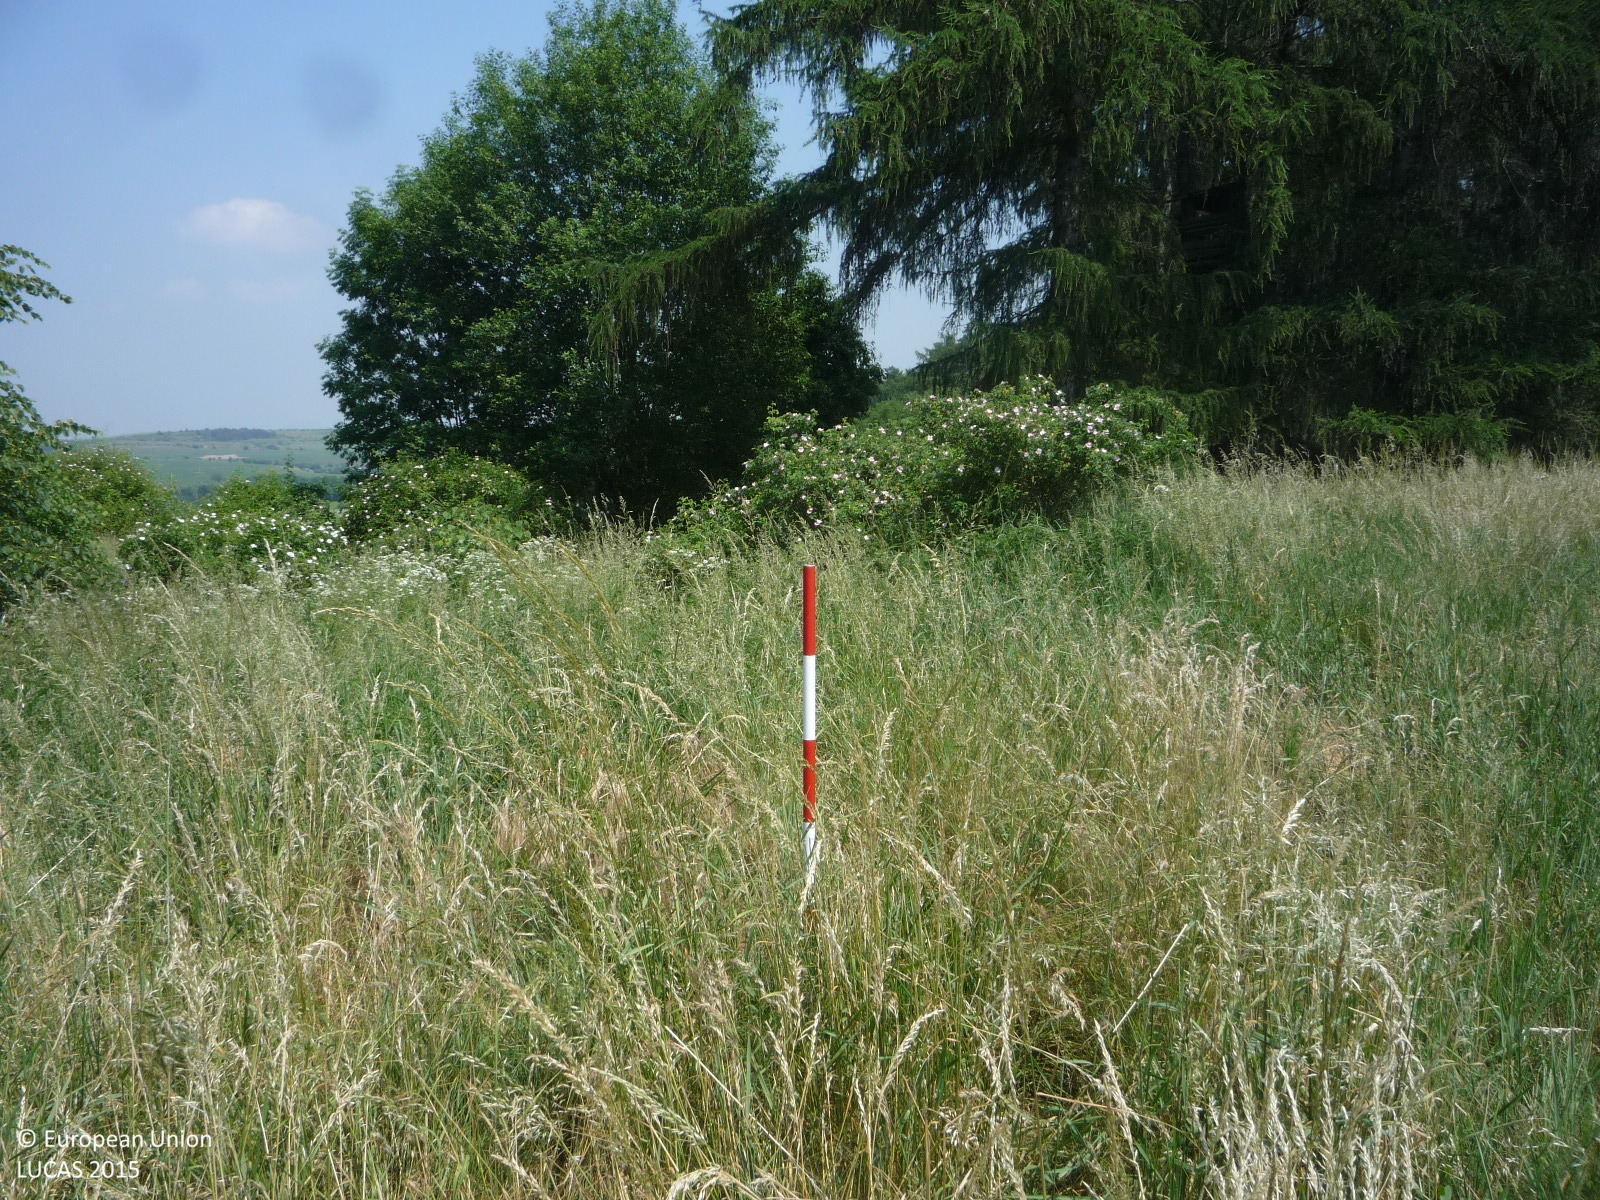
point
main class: Grassland
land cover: Grassland with sparse tree/shrub cover
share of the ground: > 75 %
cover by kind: herbaceous plants 90 %, broadleaved forest trees 5 %, shrubs 5 %
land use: Semi-natural and natural areas not in use
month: June
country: CZ
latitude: 50.2562
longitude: 14.0545
